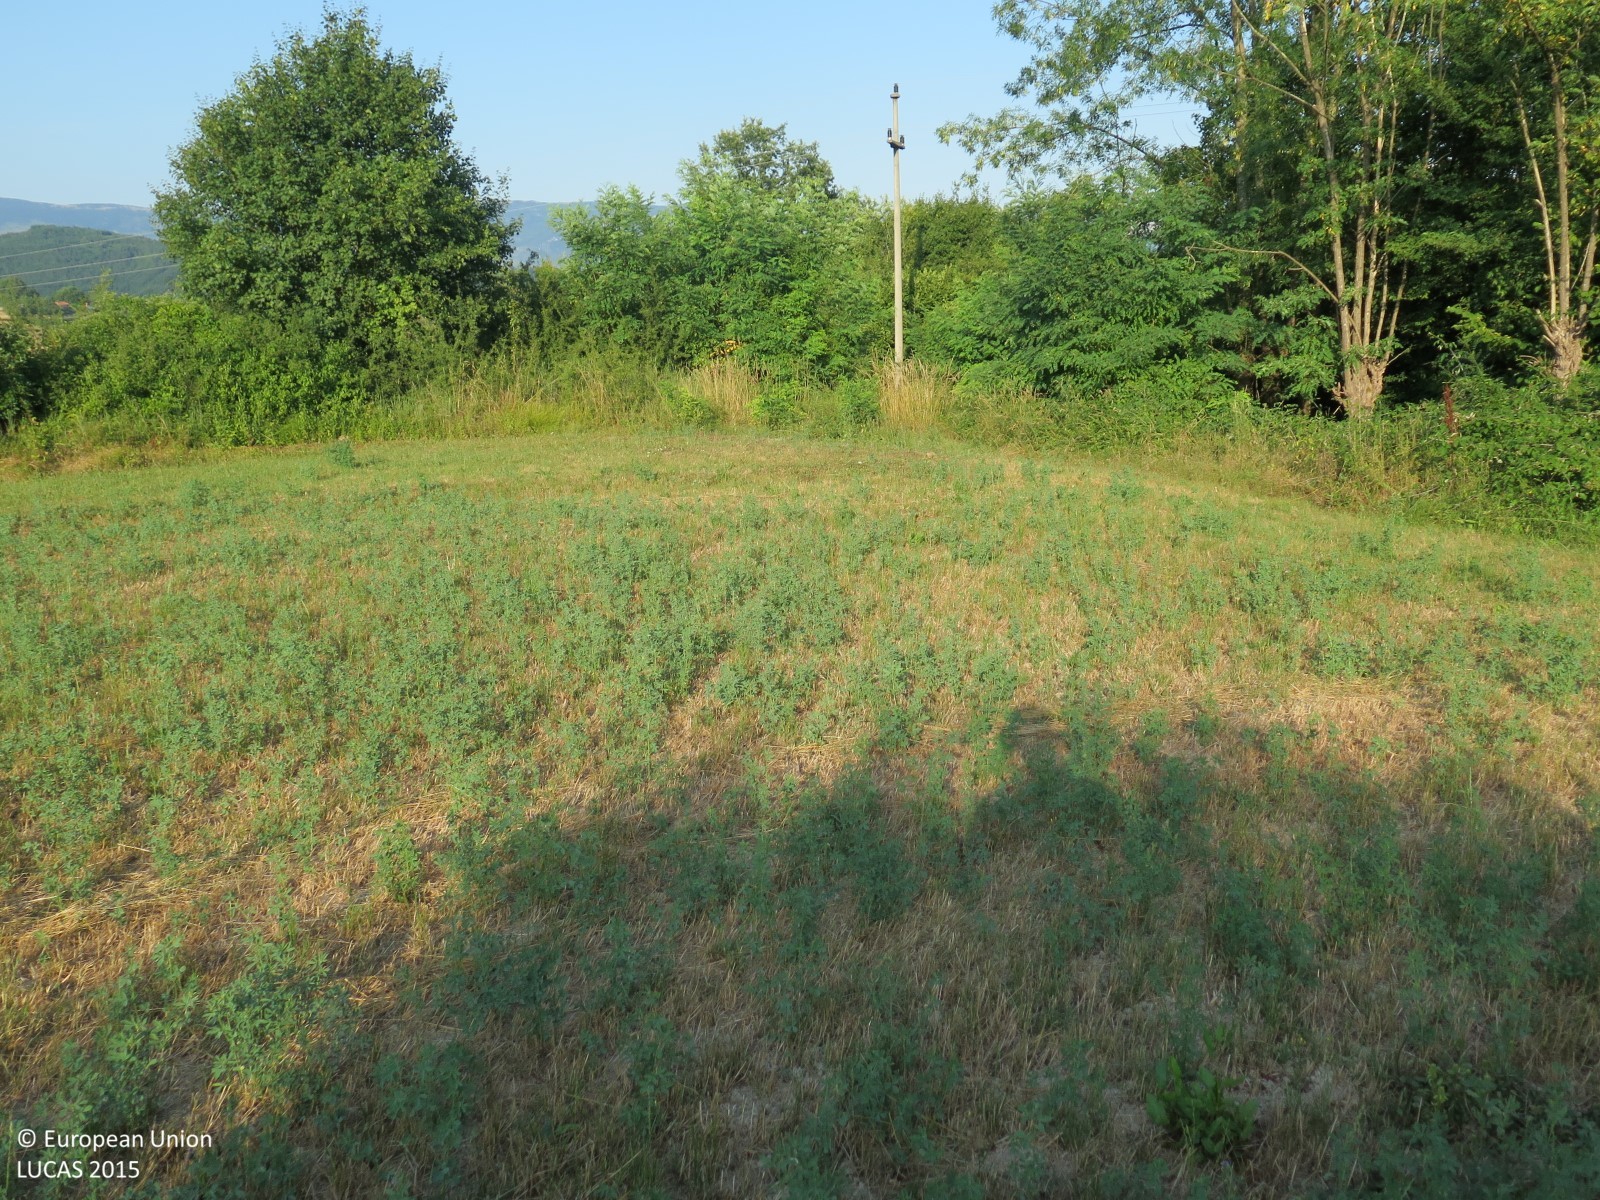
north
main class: Cropland
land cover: Lucerne
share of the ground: > 75 %
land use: Agriculture (excluding fallow land and kitchen gardens)
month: July
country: HR
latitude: 45.2100
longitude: 14.0564
